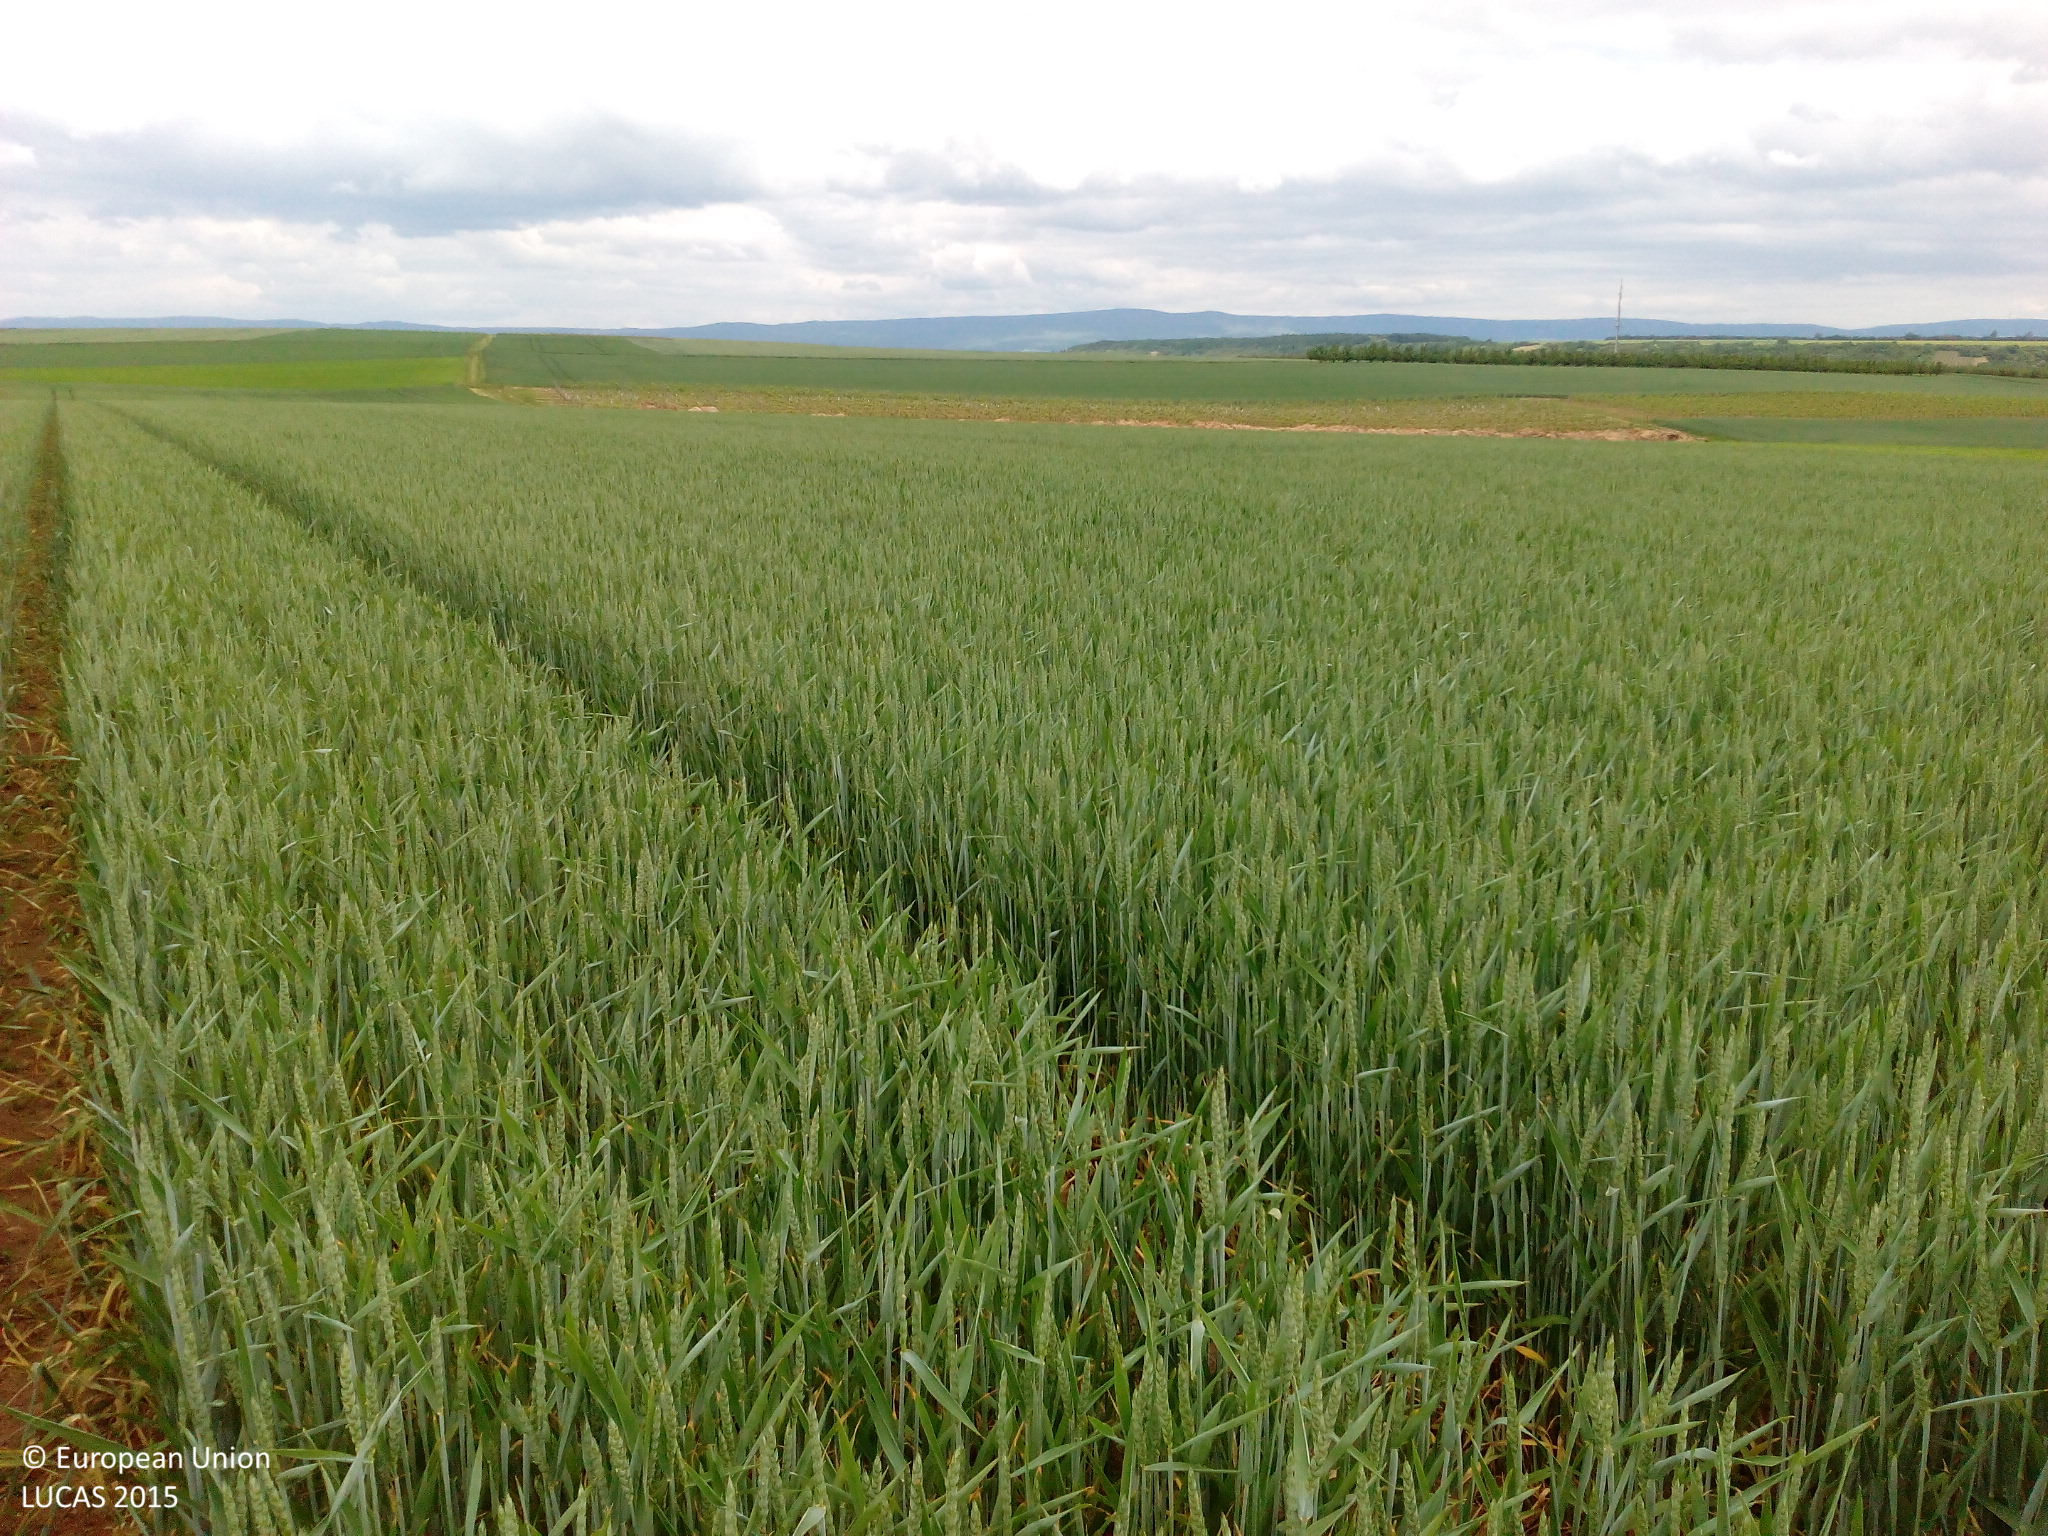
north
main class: Cropland
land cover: Common wheat
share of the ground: > 75 %
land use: Agriculture (excluding fallow land and kitchen gardens)
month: May
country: DE
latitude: 49.9155
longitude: 8.0368
